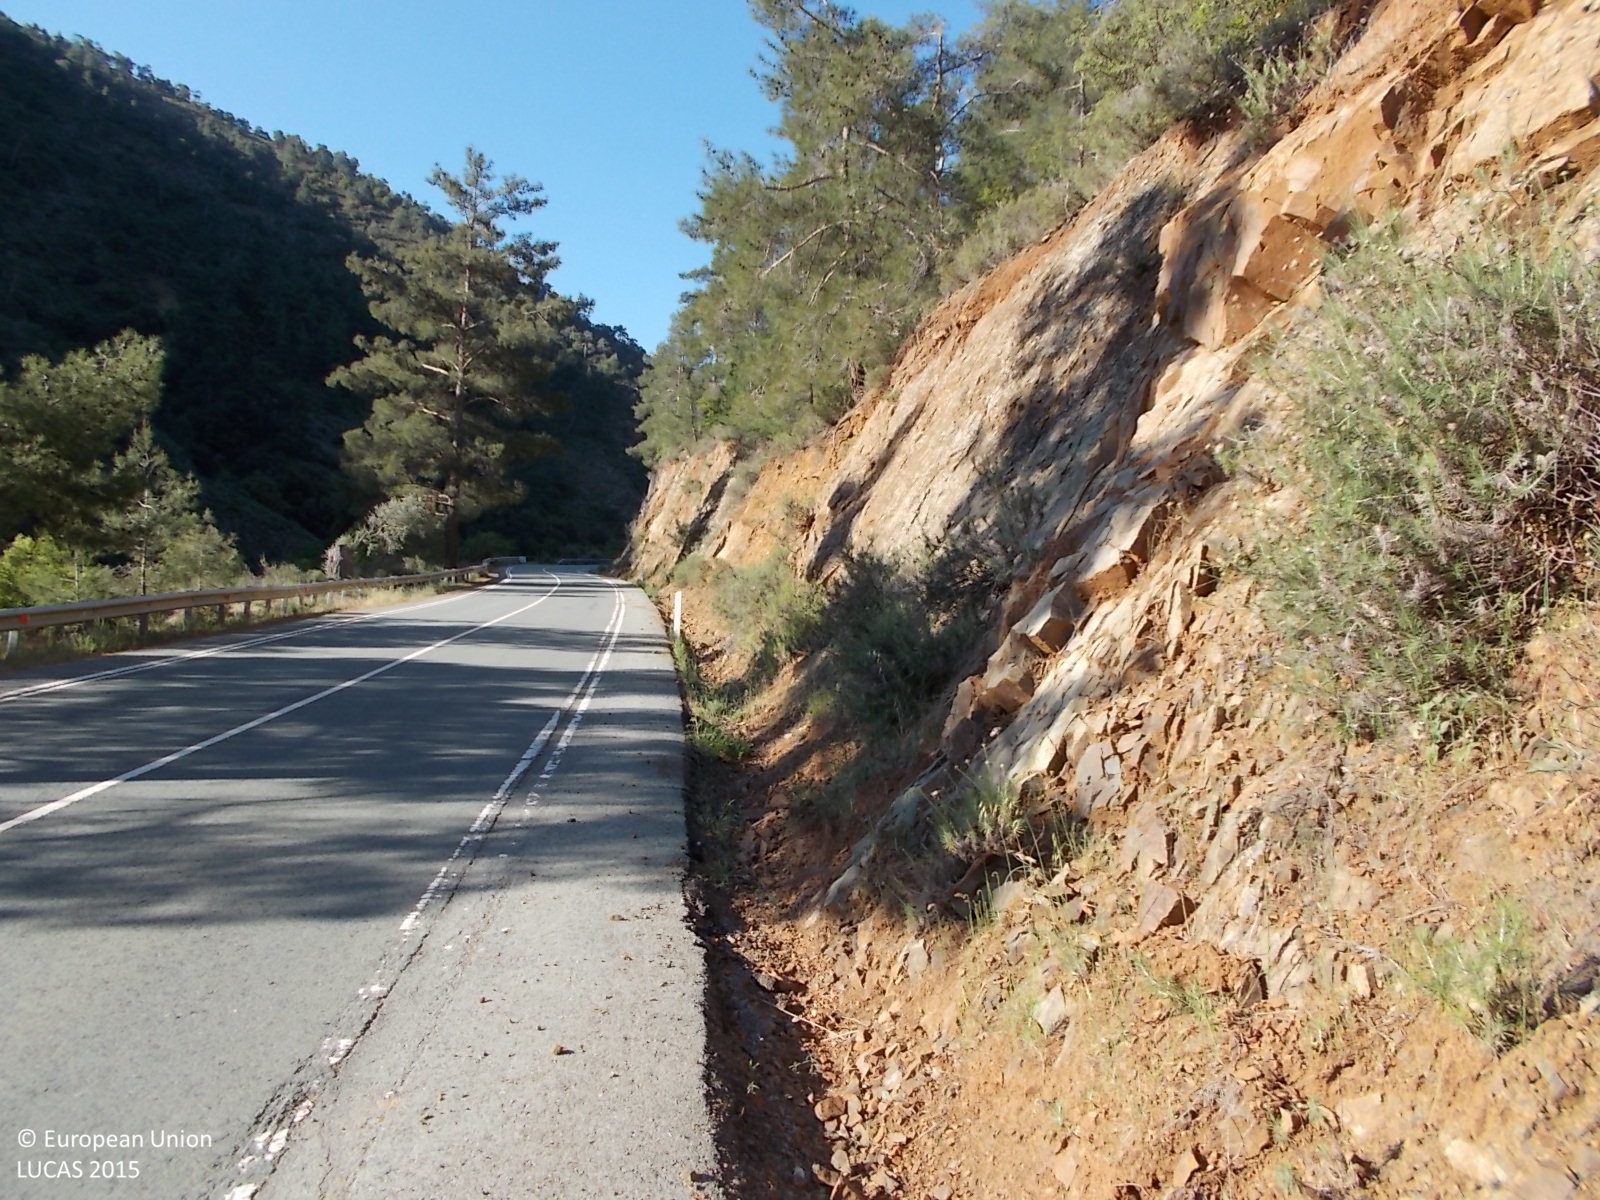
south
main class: Woodland
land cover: Pine dominated coniferous woodland
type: coniferous forest of the mediterranean region
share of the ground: > 75 %
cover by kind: coniferous forest trees 100 %
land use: Semi-natural and natural areas not in use
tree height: > 5 m
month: May
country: CY
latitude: 34.9849
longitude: 33.0602
